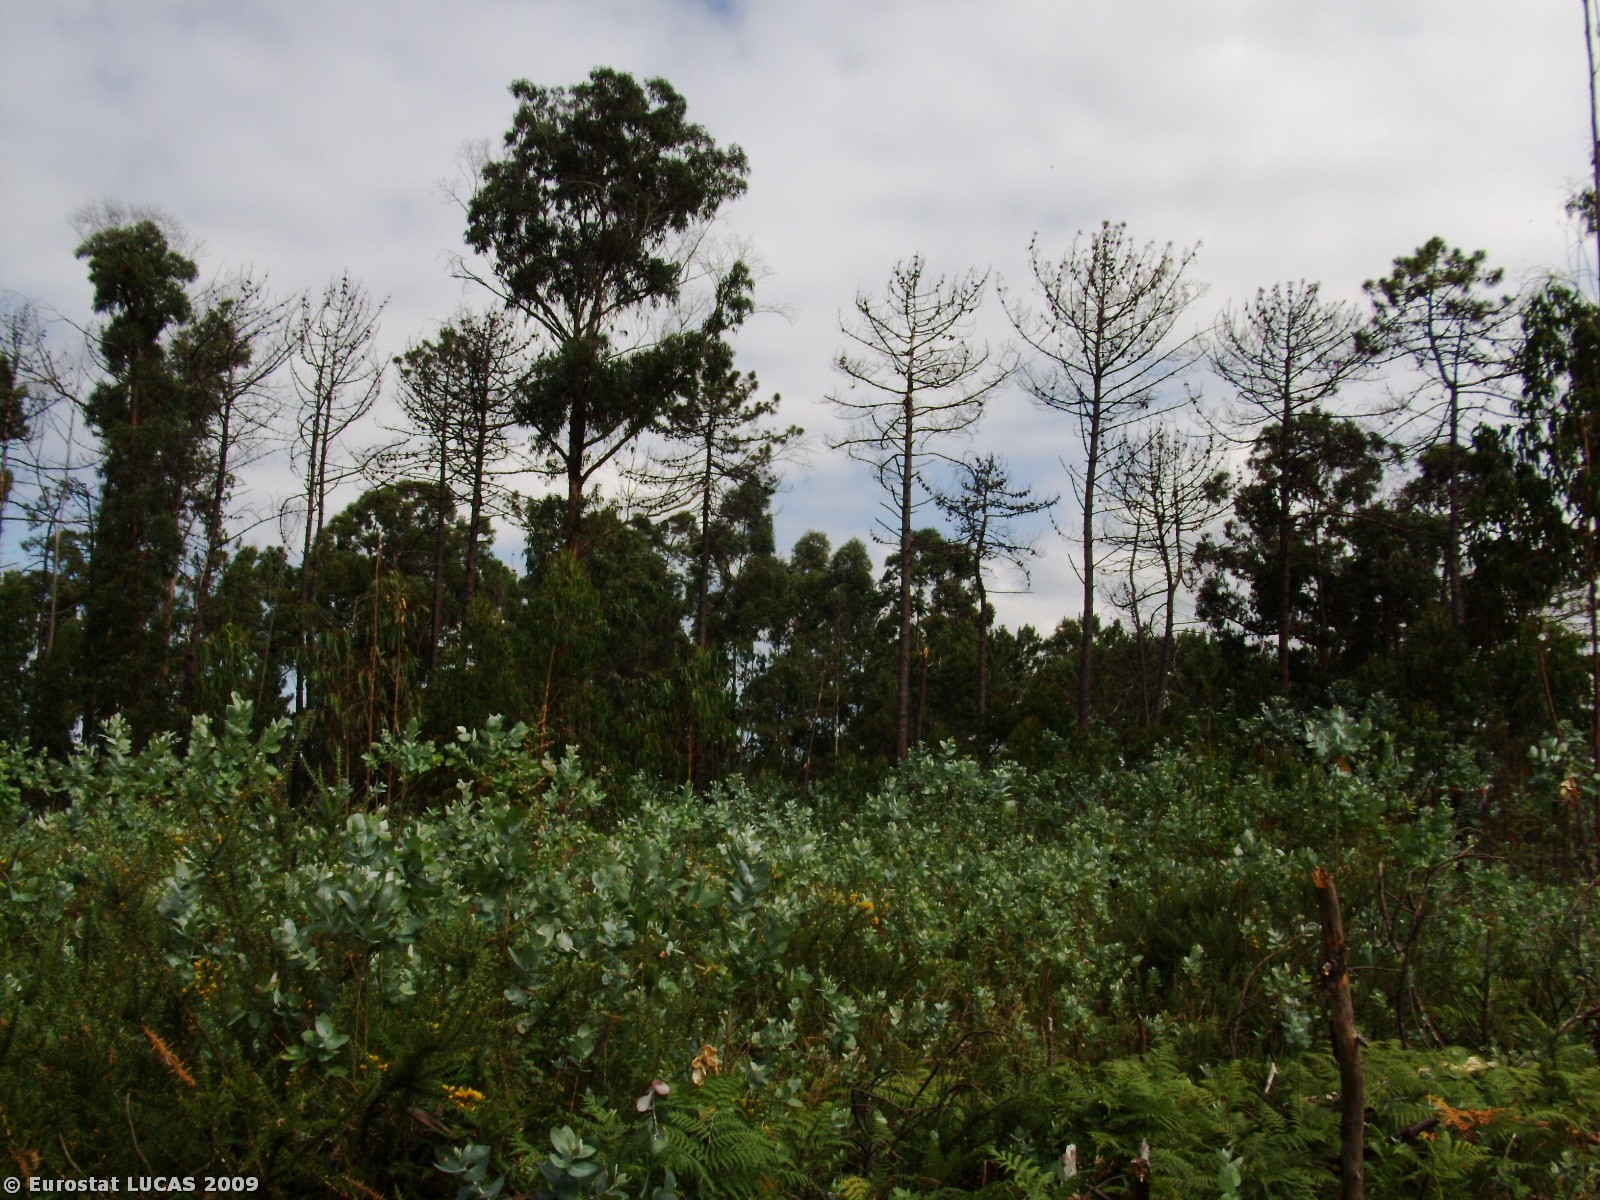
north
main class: Woodland
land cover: Broadleaved woodland
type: plantations and self-sown exotic forest
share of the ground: 50 - 75 %
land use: Forestry
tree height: > 5 m
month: June
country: PT
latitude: 41.4613
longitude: -8.7307
